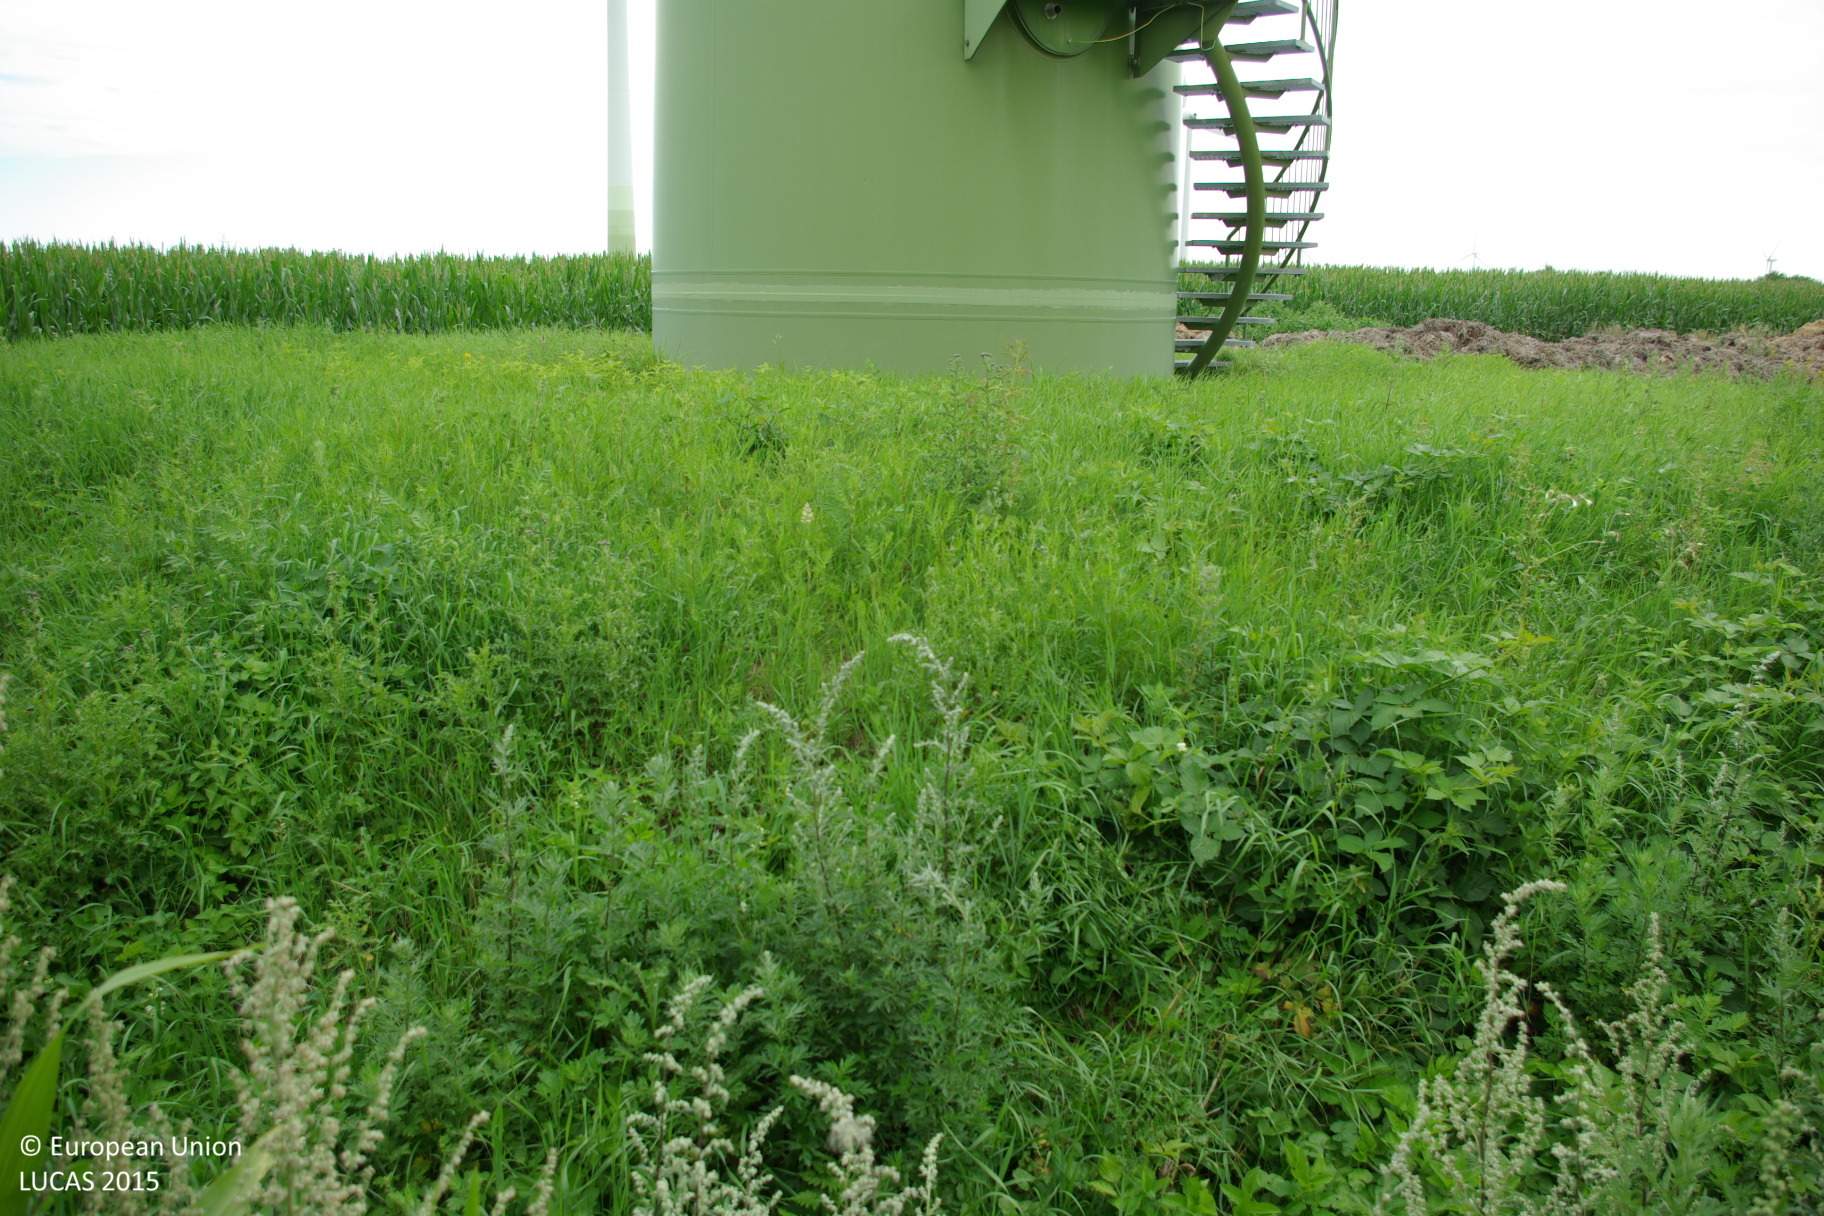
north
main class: Cropland
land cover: Maize
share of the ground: > 75 %
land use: Agriculture (excluding fallow land and kitchen gardens)
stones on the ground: 10 - 25 %
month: August
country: DE
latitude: 54.4416
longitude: 9.1833
